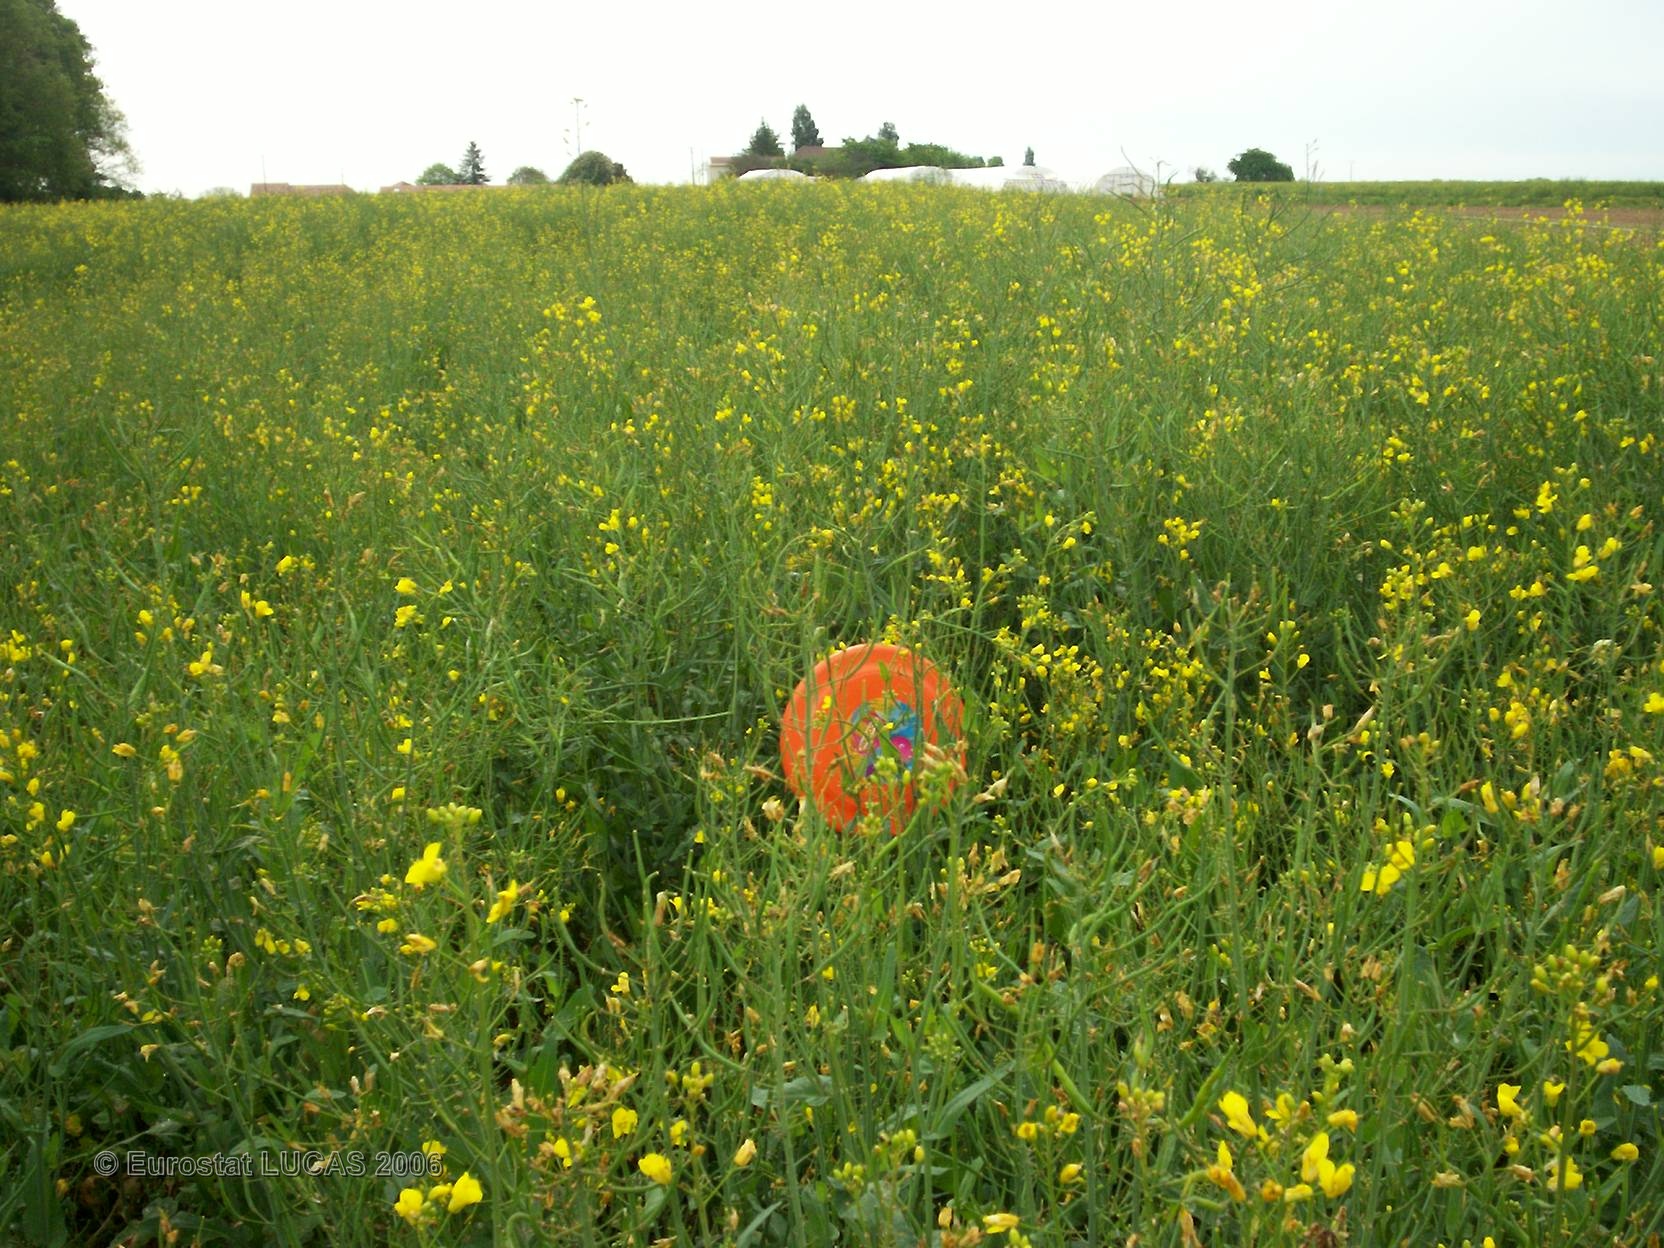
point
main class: Cropland
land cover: Rape and turnip rape
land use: Agriculture (excluding fallow land and kitchen gardens)
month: May
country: FR
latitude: 46.7132
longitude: 0.3657
